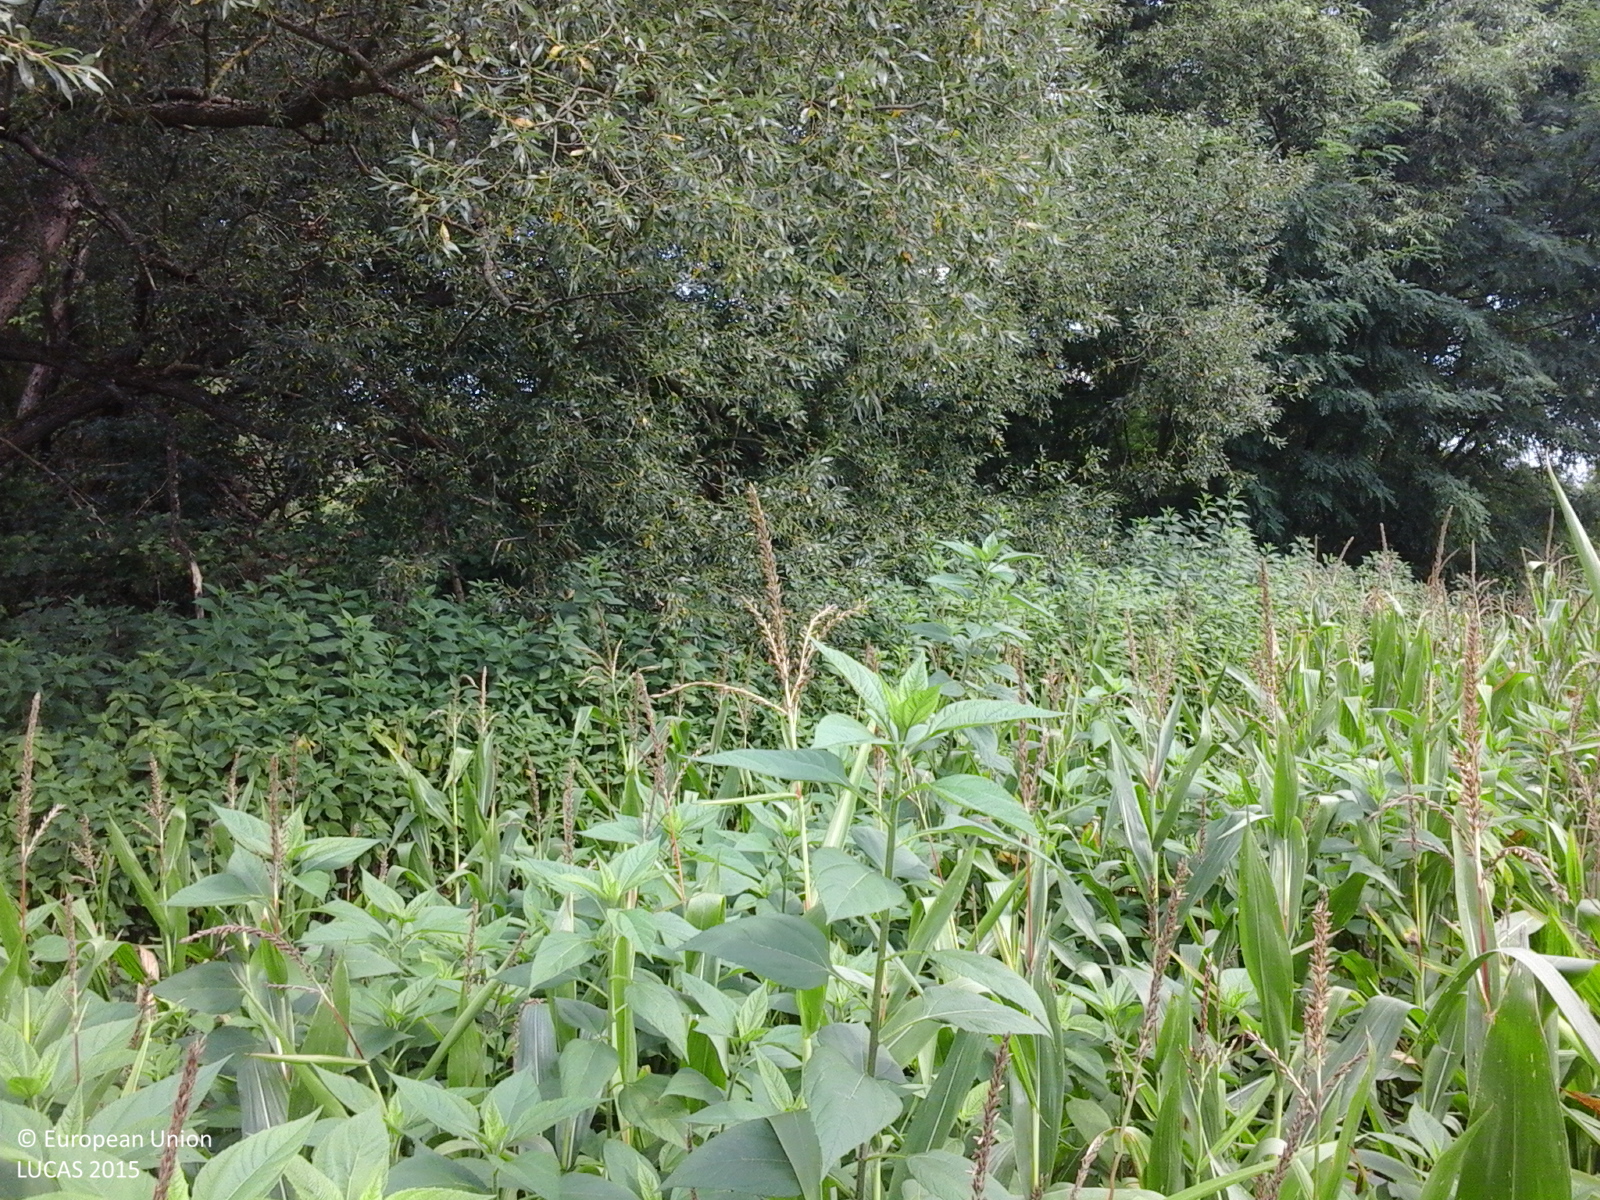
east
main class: Cropland
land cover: Maize
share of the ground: > 75 %
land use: Agriculture (excluding fallow land and kitchen gardens)
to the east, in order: Maize; Tracks; Broadleaved woodland; Tracks; Broadleaved woodland; Inland fresh running water; Broadleaved woodland; Arable land (only in case pi)
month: August
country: RO
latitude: 46.3040
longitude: 22.2119
